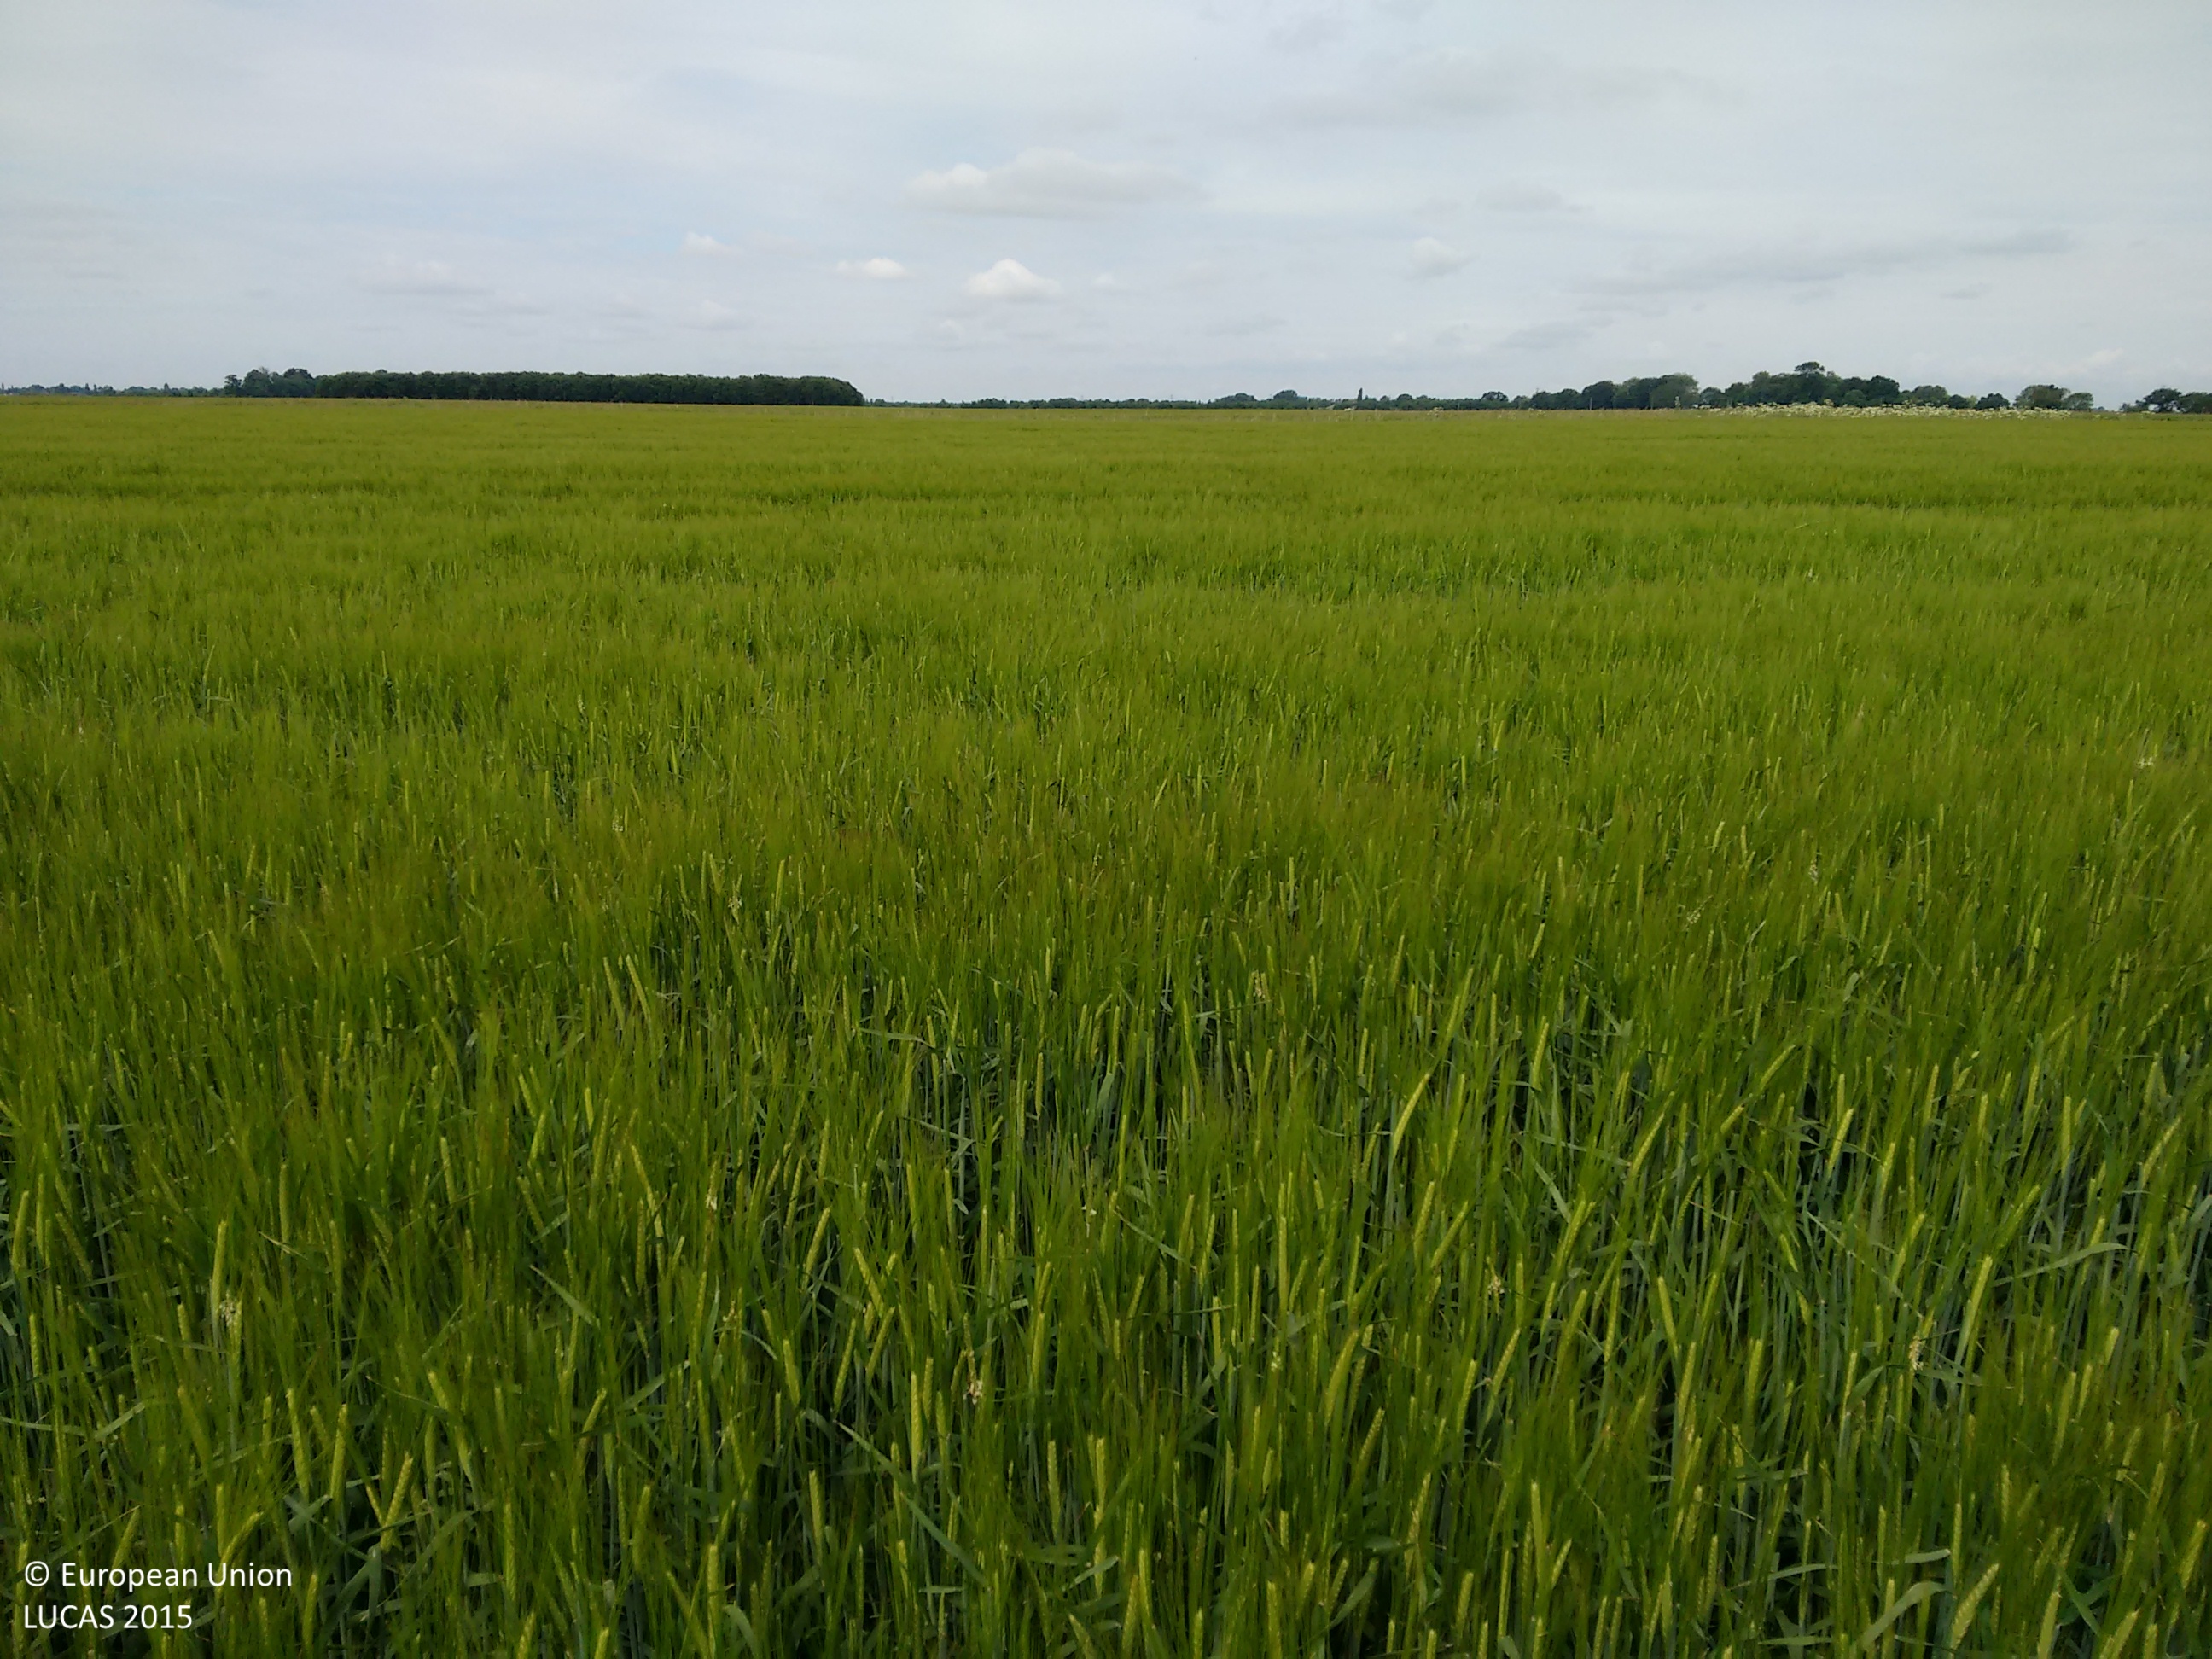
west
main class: Cropland
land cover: Barley
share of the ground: > 75 %
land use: Agriculture (excluding fallow land and kitchen gardens)
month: June
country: GB
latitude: 52.6371
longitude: -0.0666
